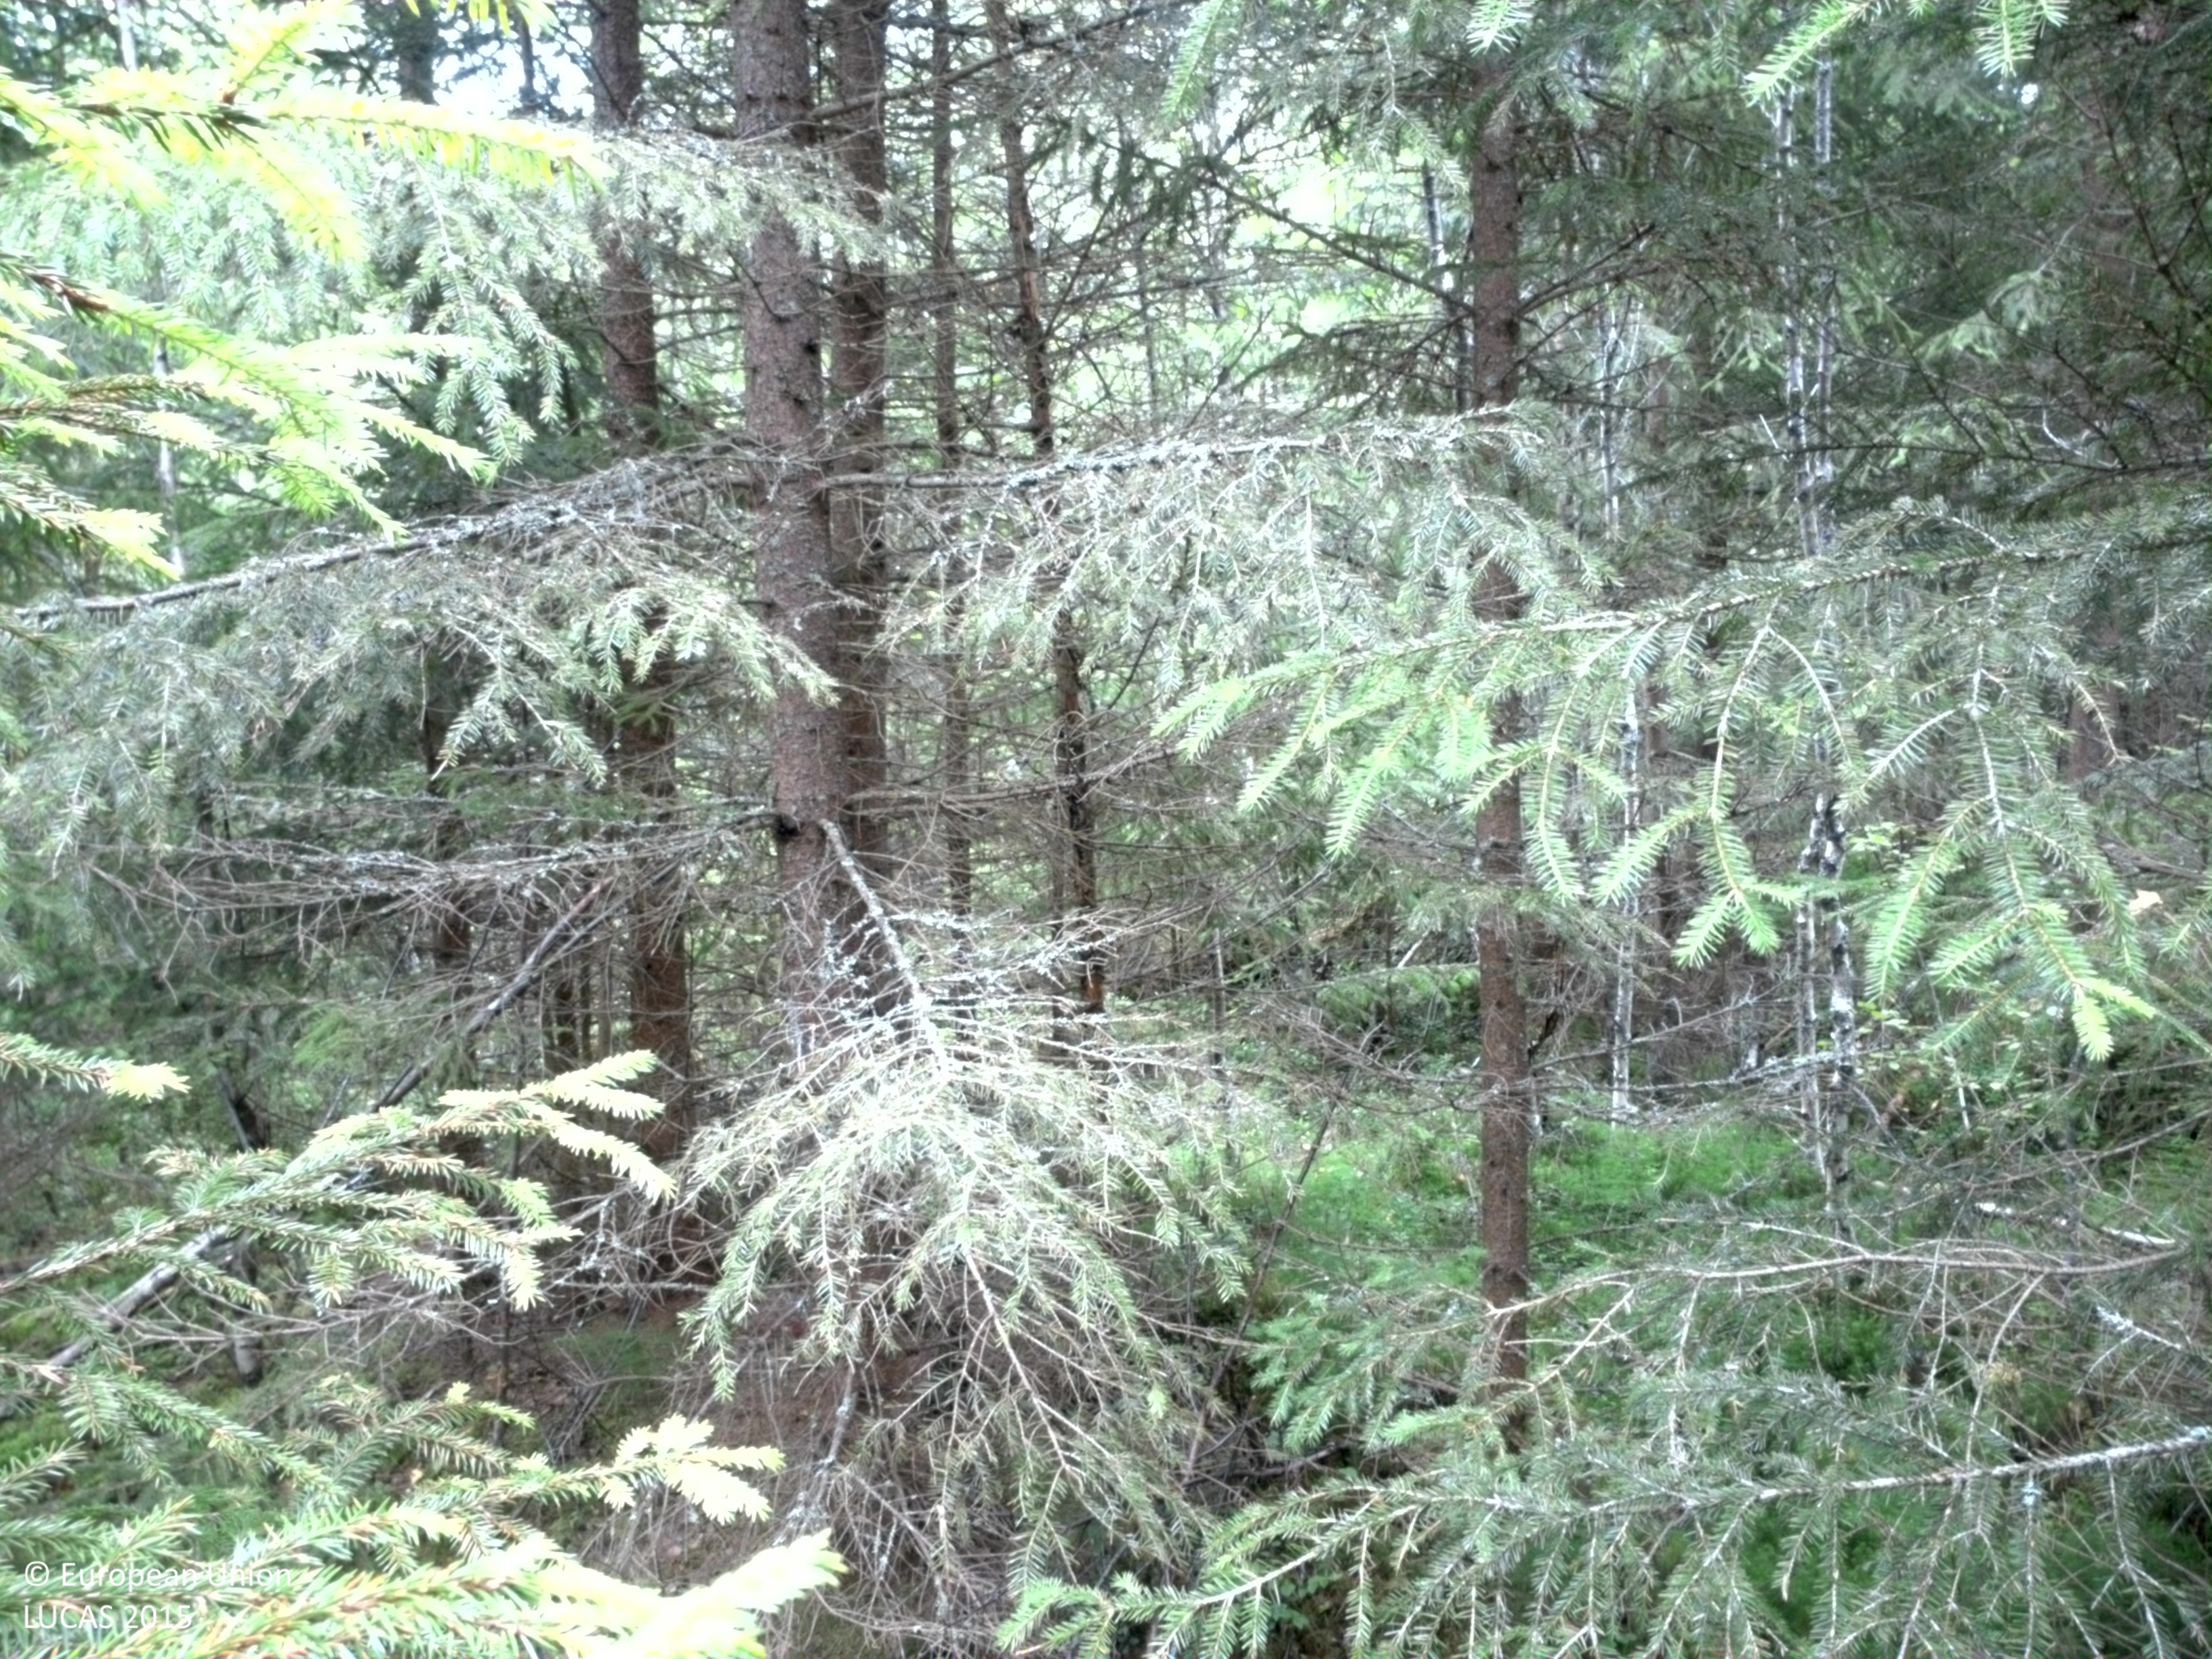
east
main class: Woodland
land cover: Spruce dominated mixed woodland
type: boreal forest
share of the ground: 50 - 75 %
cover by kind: coniferous forest trees 50 %, broadleaved forest trees 20 %, herbaceous plants 15 %, lichens and mosses 15 %
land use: Forestry
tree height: > 5 m
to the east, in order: Spruce dominated mixed woodland; Tracks; Spruce dominated mixed woodland; Tracks; Spruce dominated coniferous woodland
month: July
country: SE
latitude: 59.4789
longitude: 13.1524
